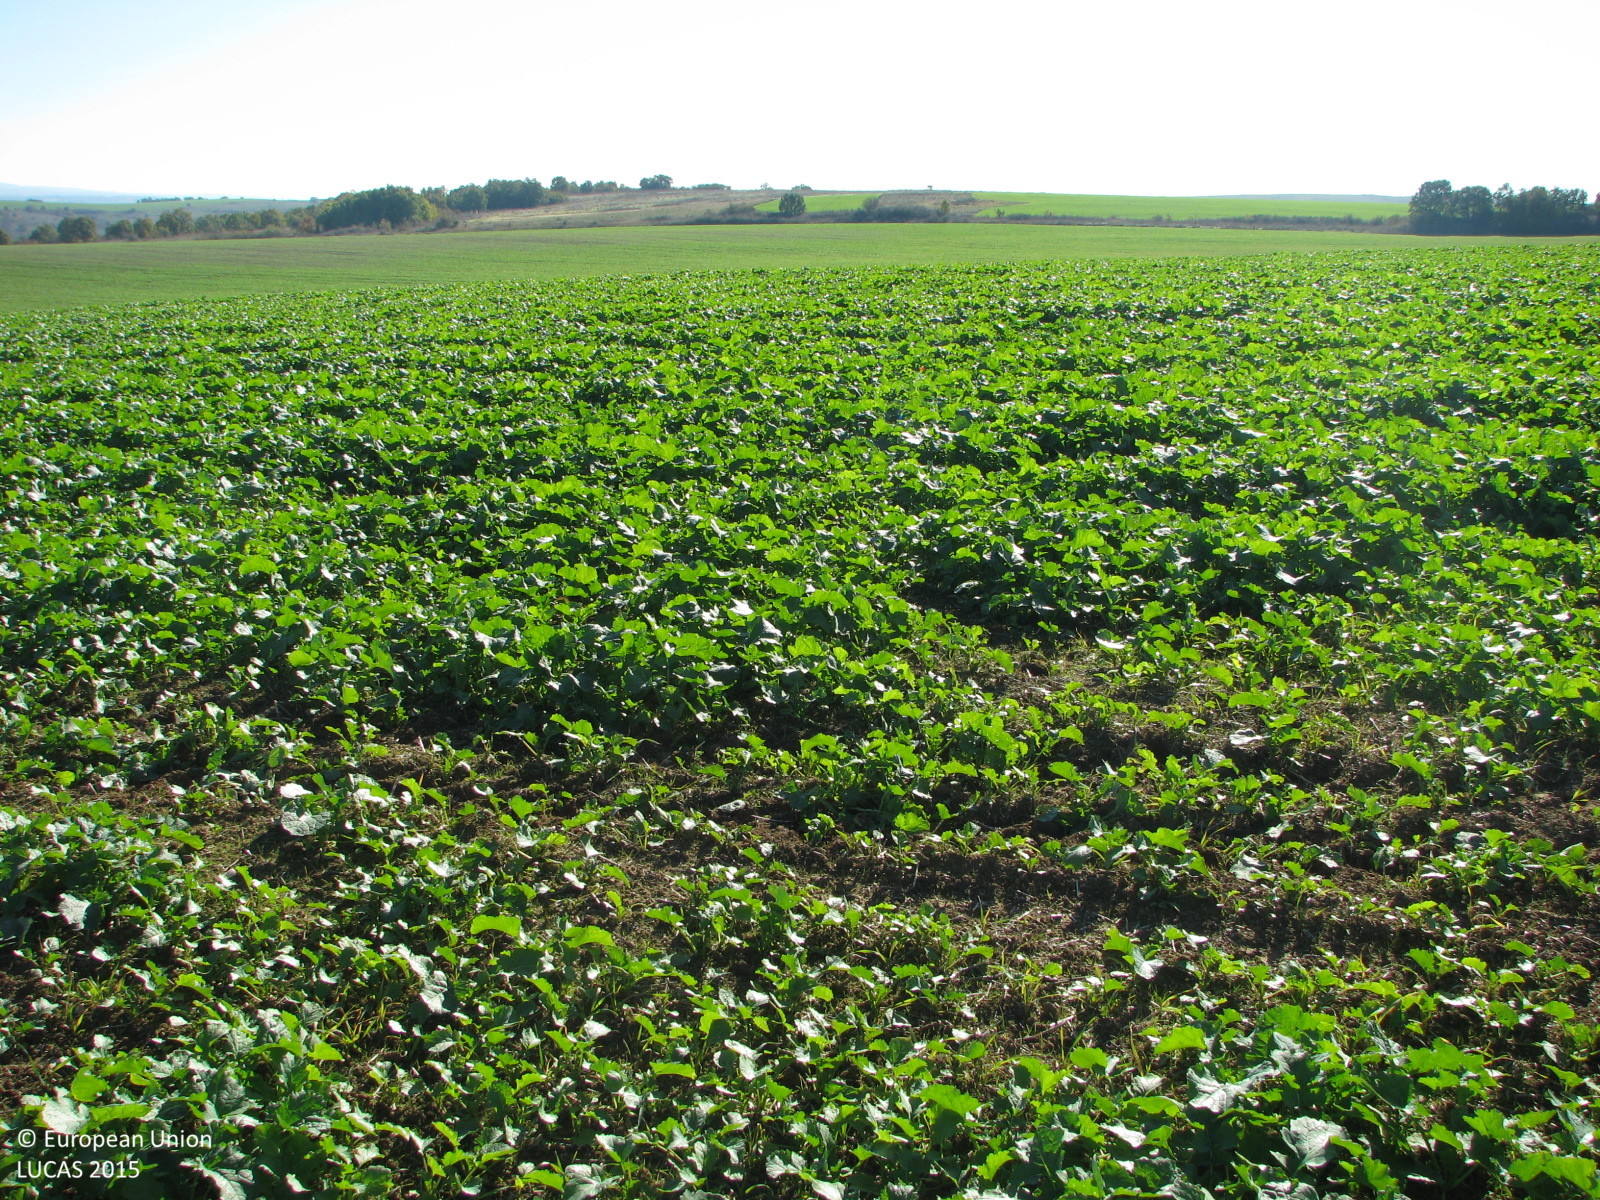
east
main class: Cropland
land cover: Rape and turnip rape
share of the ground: > 75 %
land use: Agriculture (excluding fallow land and kitchen gardens)
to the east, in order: Rape and turnip rape; Grassland without tree/shrub cover
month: November
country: BG
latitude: 42.1186
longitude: 26.8228
